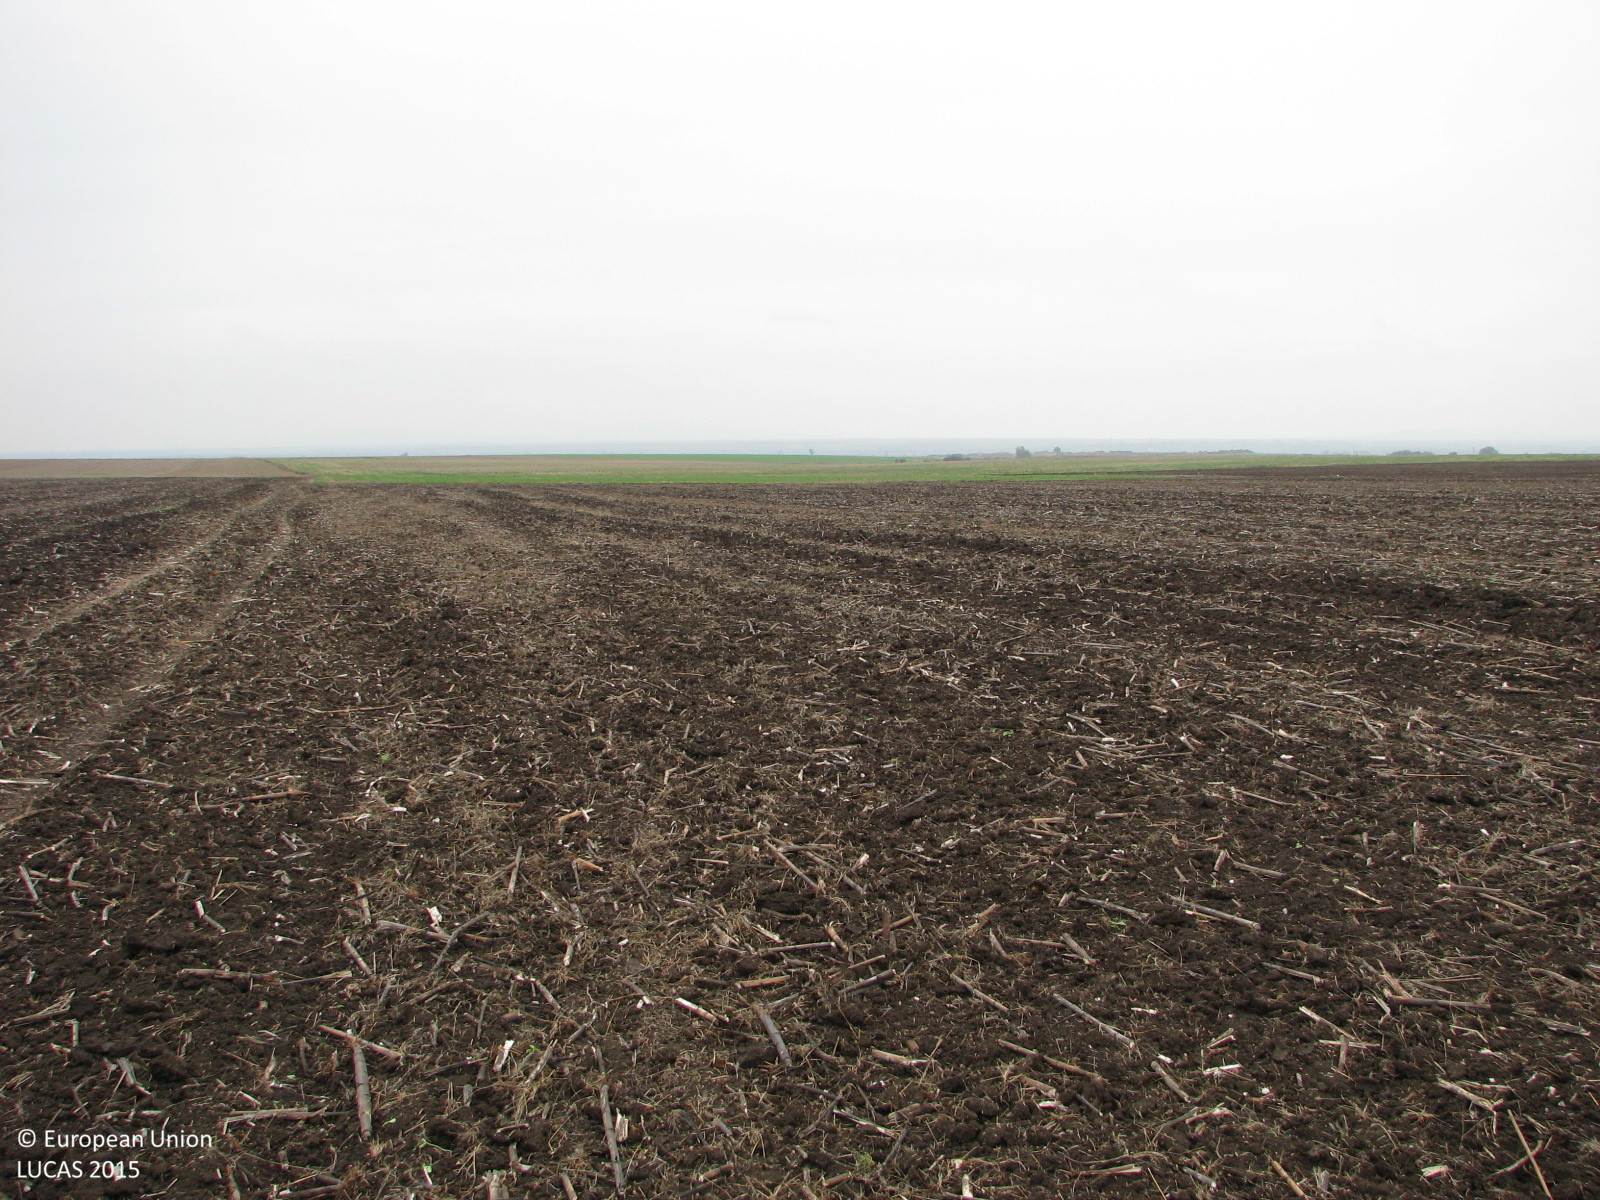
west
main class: Cropland
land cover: Sunflower
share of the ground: < 10 %
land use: Agriculture (excluding fallow land and kitchen gardens)
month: October
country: BG
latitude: 42.4163
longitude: 26.5839
